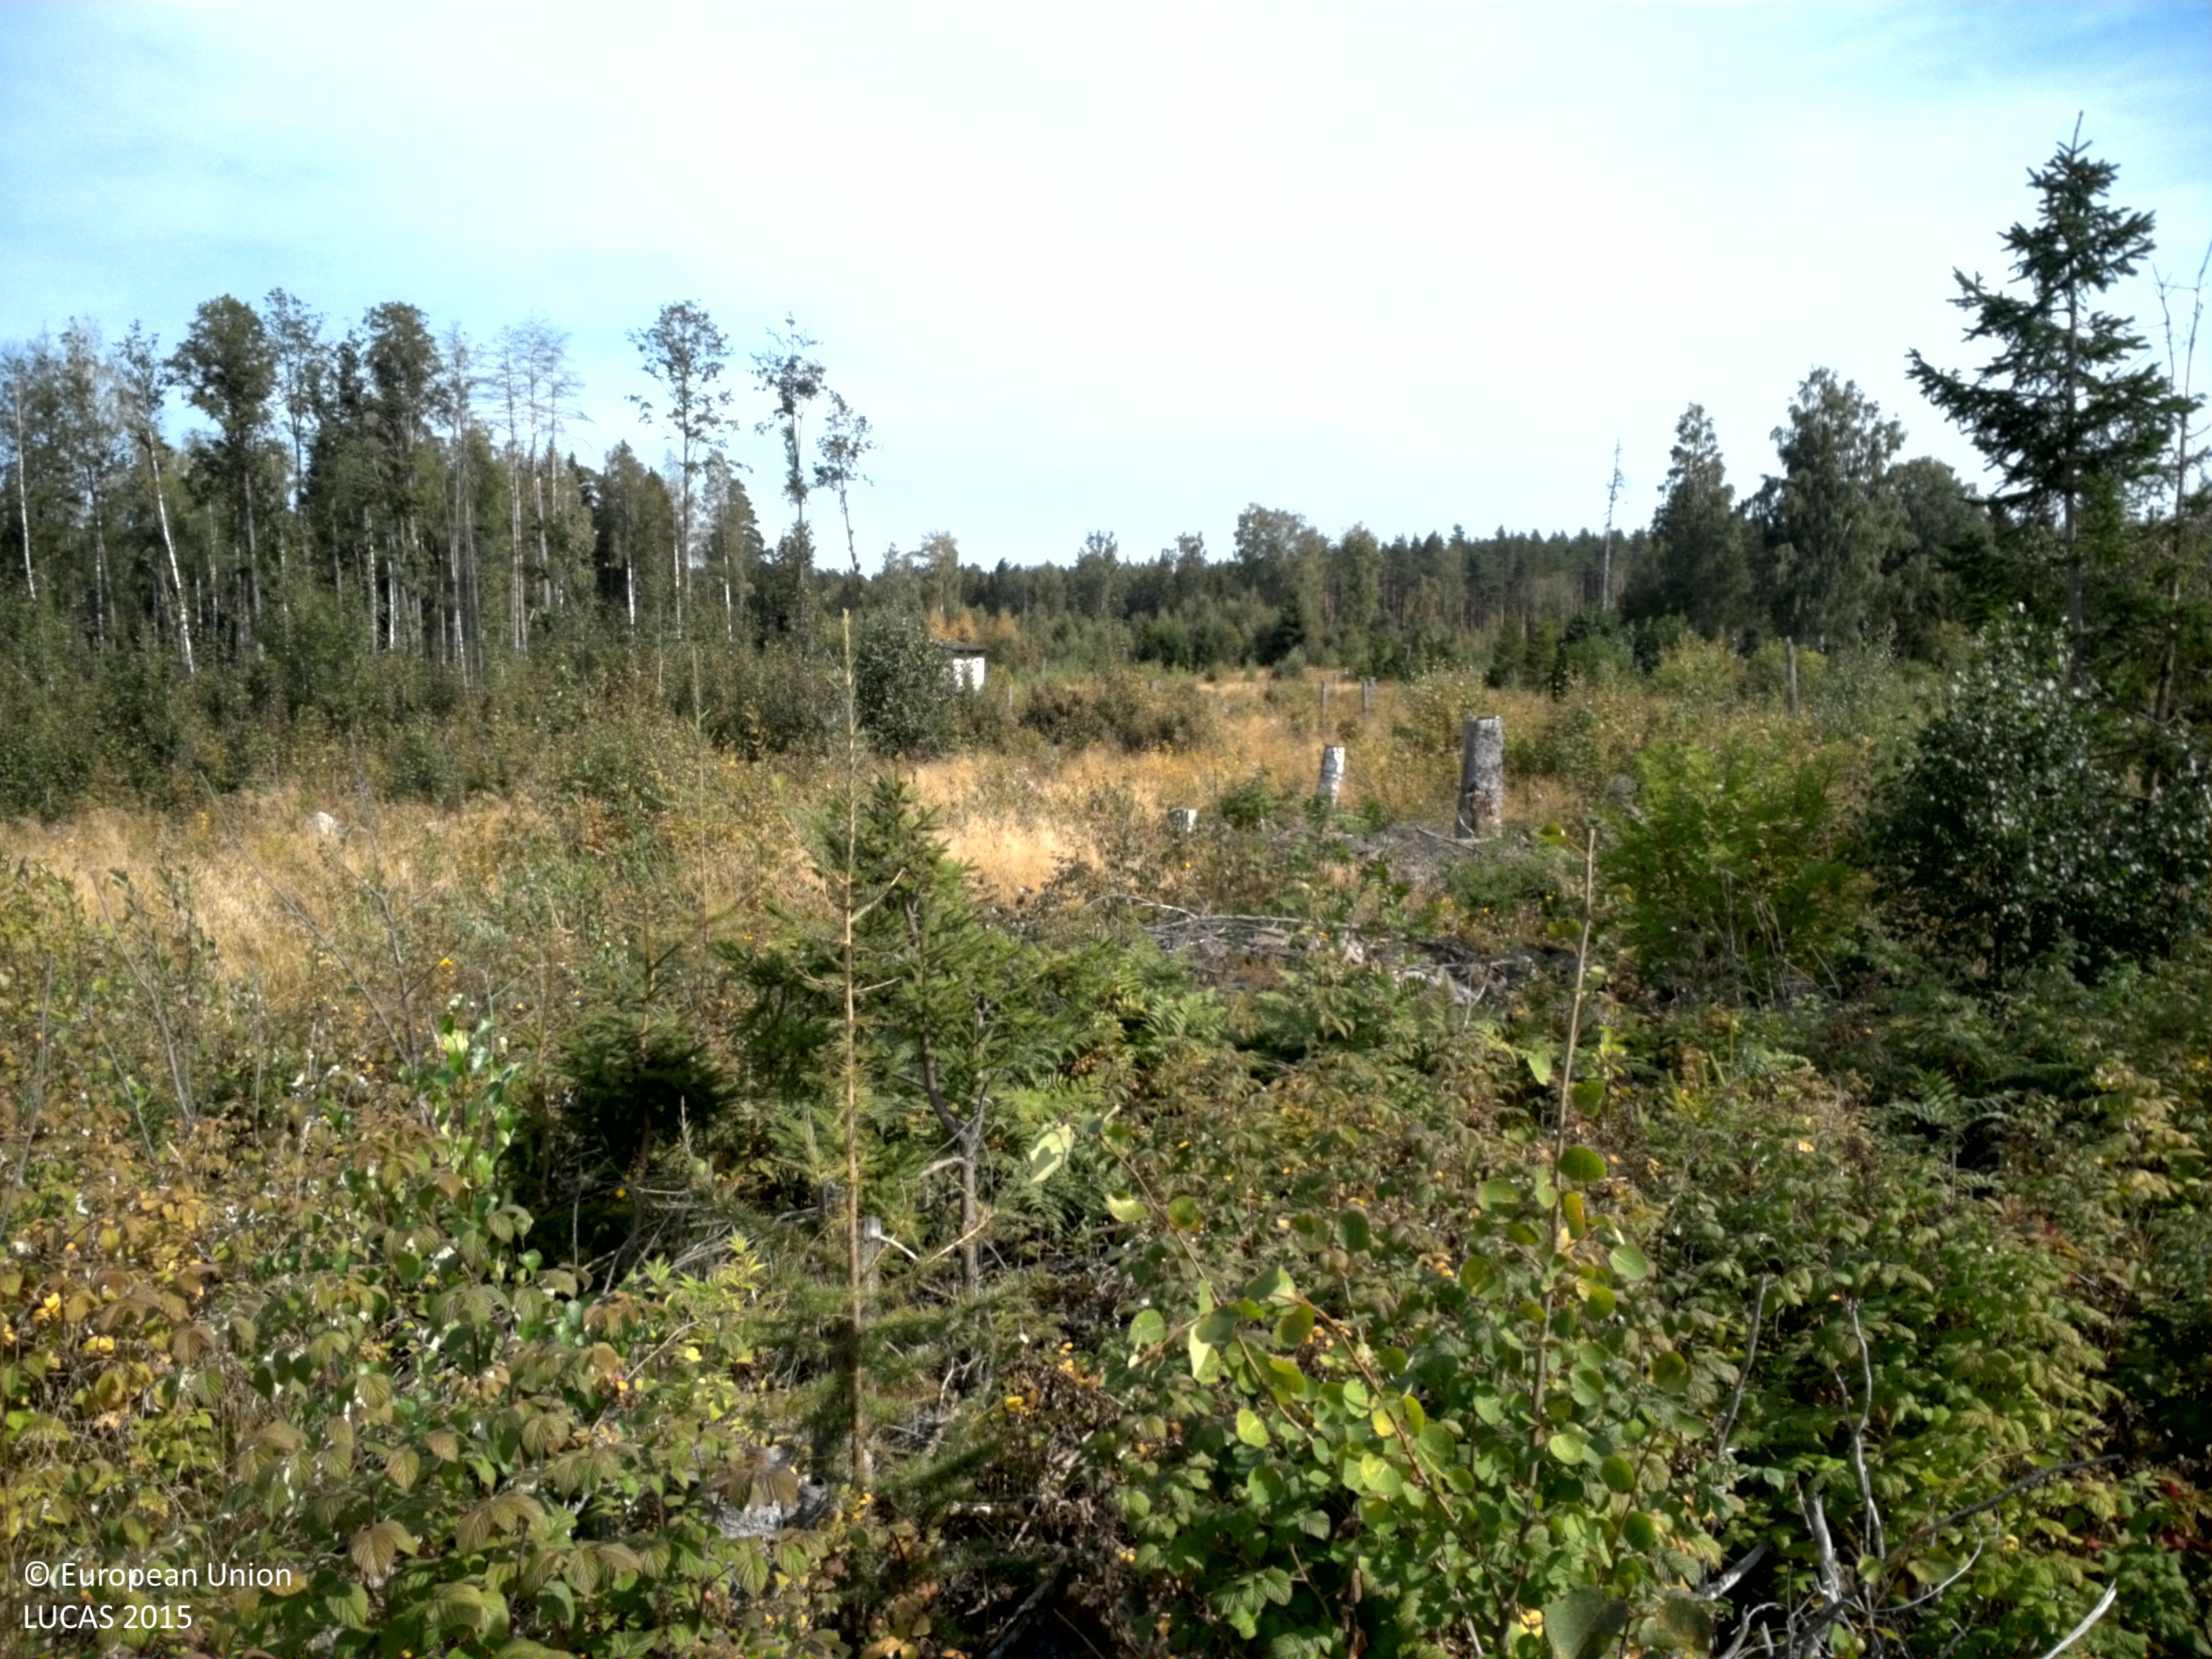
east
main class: Woodland
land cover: Broadleaved woodland
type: boreal forest
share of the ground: 25 - 50 %
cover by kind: broadleaved forest trees 40 %, herbaceous plants 30 %, shrubs 20 %, coniferous forest trees 10 %
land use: Forestry
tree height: < 5 m
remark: Clear cut
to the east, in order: Broadleaved woodland; Grassland with sparse tree/shrub cover; Shrubland with sparse tree cover; Grassland with sparse tree/shrub cover; Broadleaved woodland
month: August
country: SE
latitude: 60.1201
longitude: 17.6051
